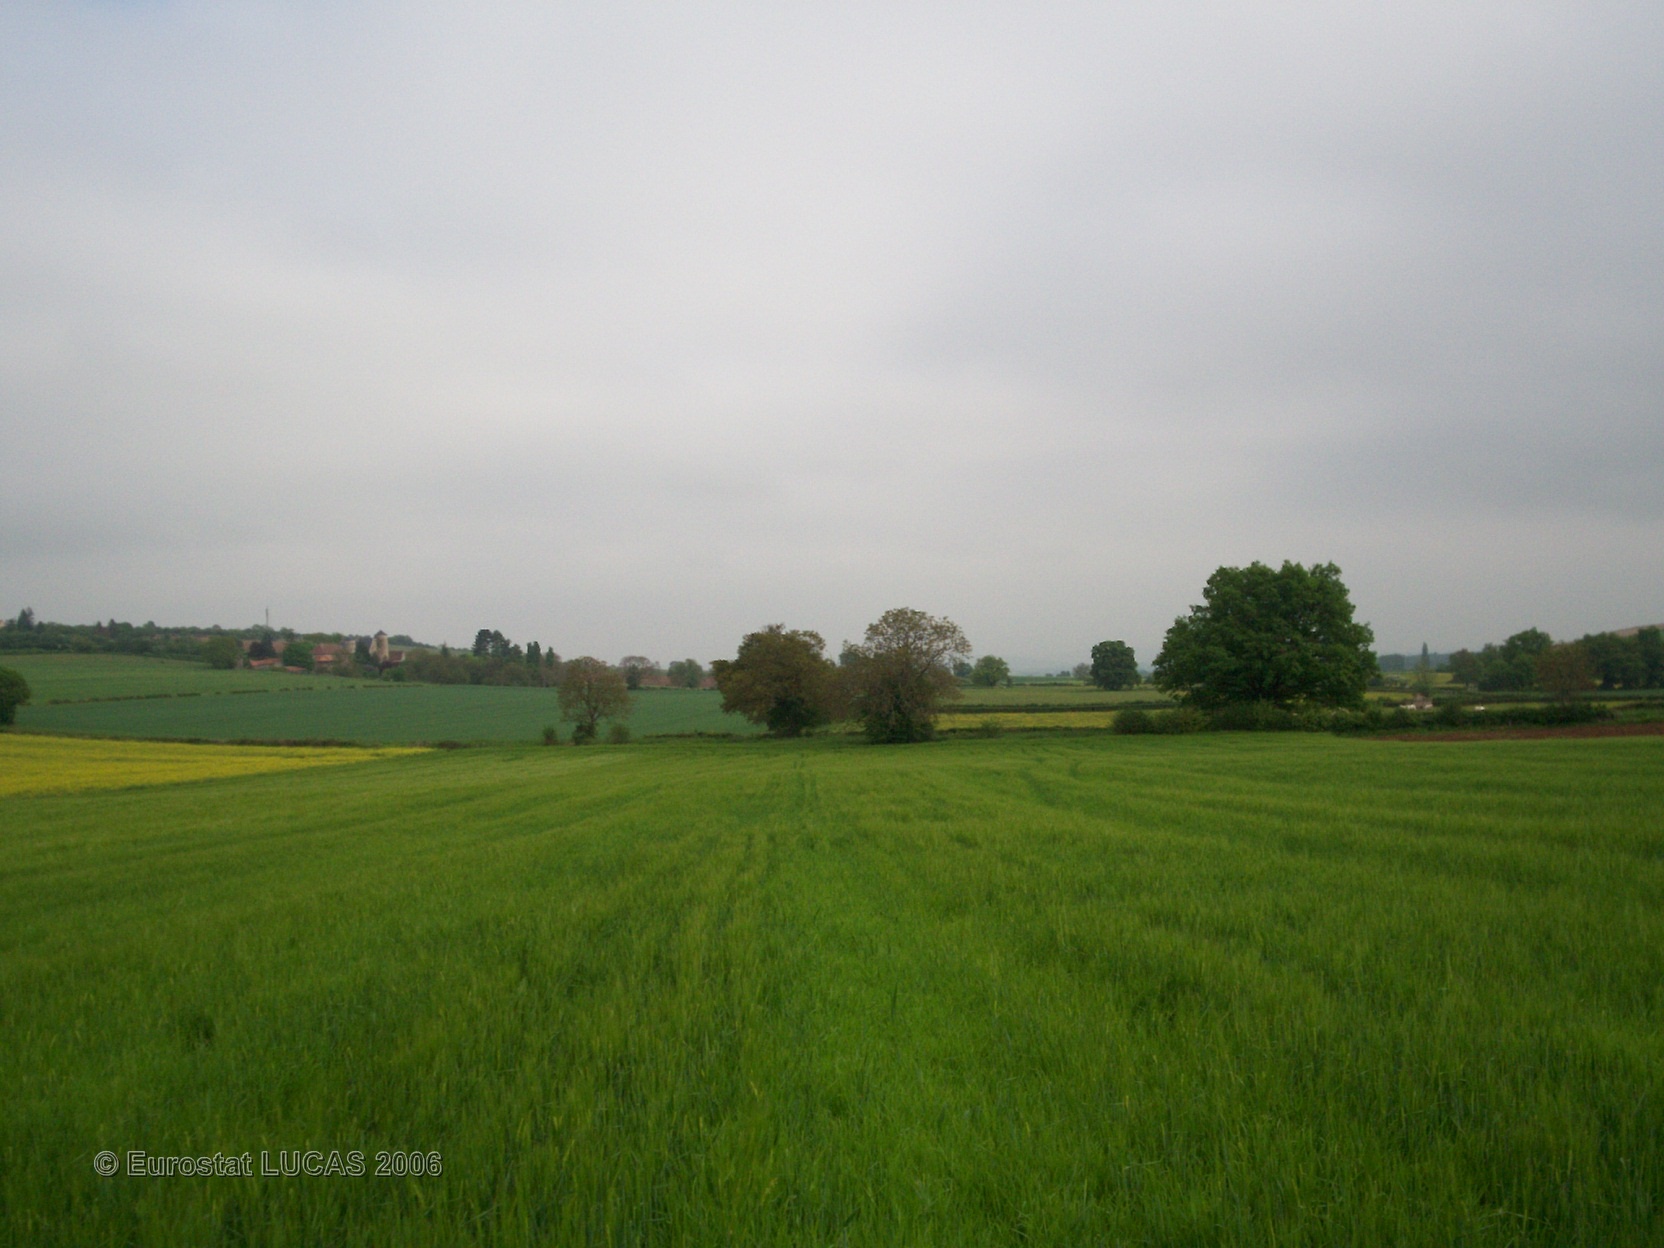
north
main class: Cropland
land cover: Barley
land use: Agriculture (excluding fallow land and kitchen gardens)
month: May
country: FR
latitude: 46.5059
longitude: 4.6455
